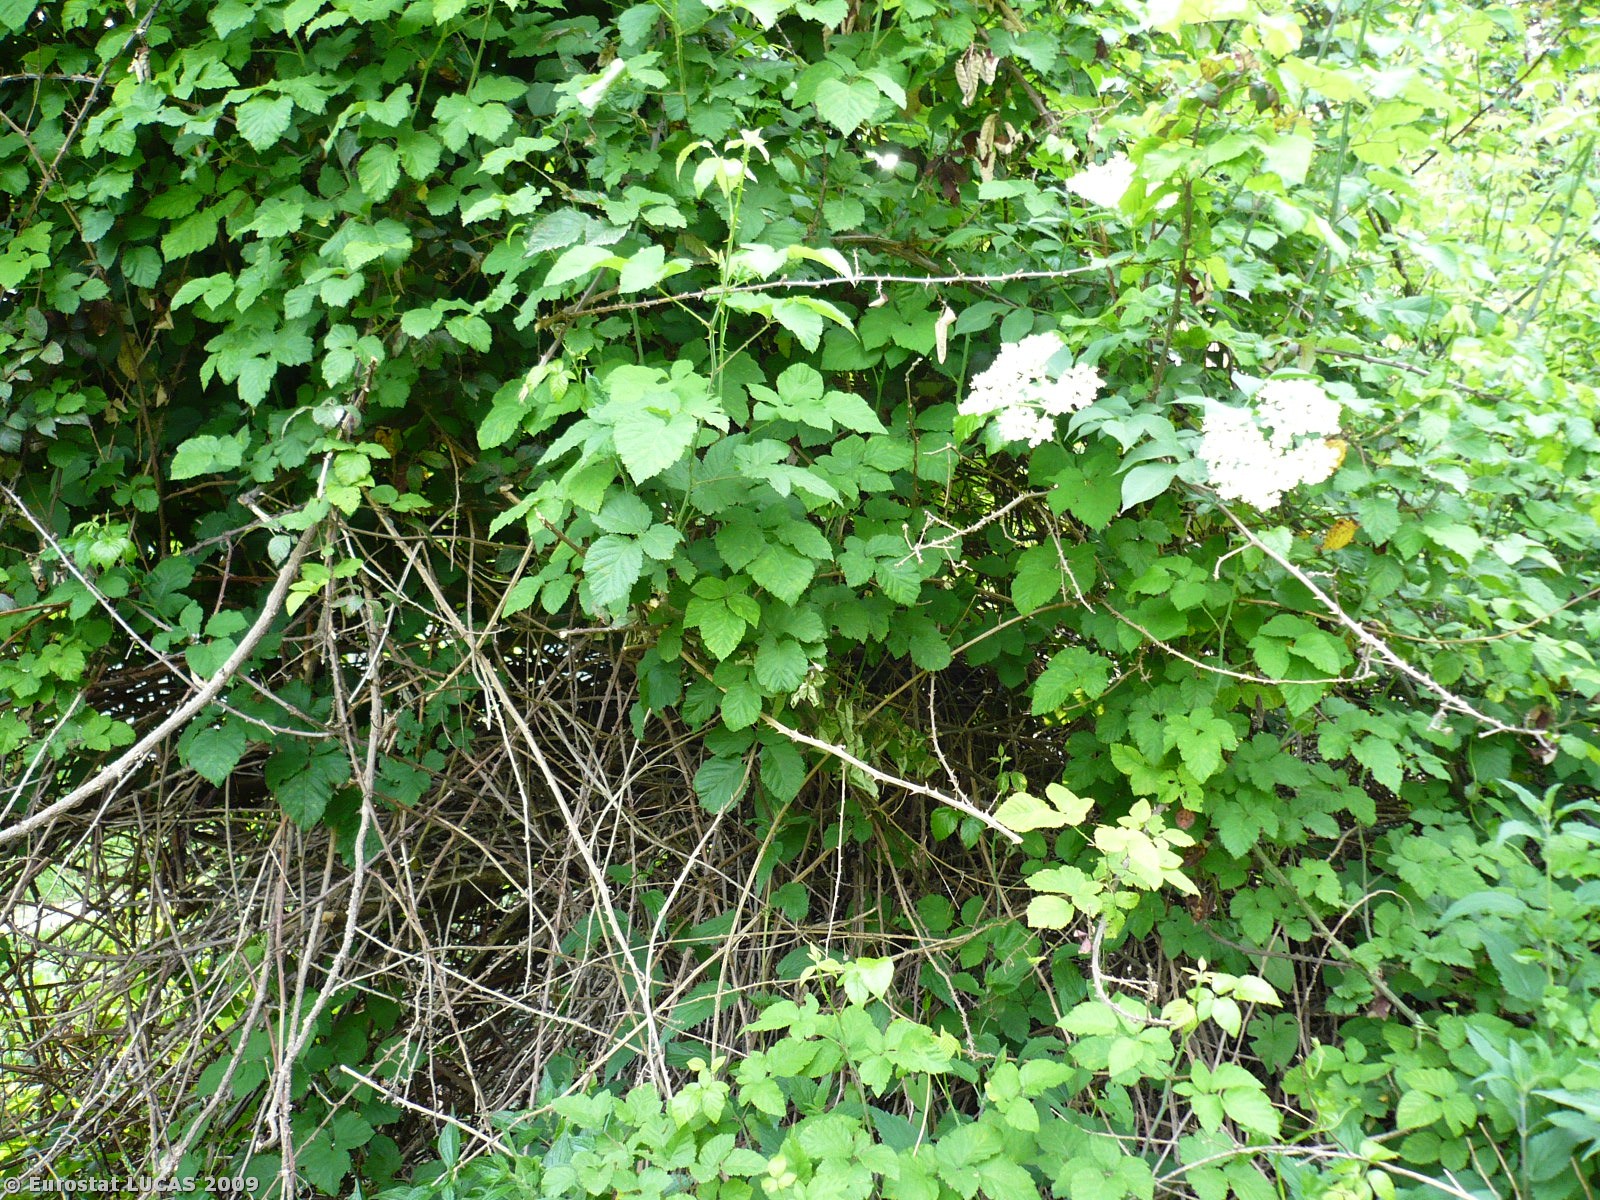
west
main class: Shrubland
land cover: Shrubland with sparse tree cover
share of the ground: 25 - 50 %
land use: Unused
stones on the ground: < 10 %
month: May
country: SI
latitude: 45.9636
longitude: 13.6738
